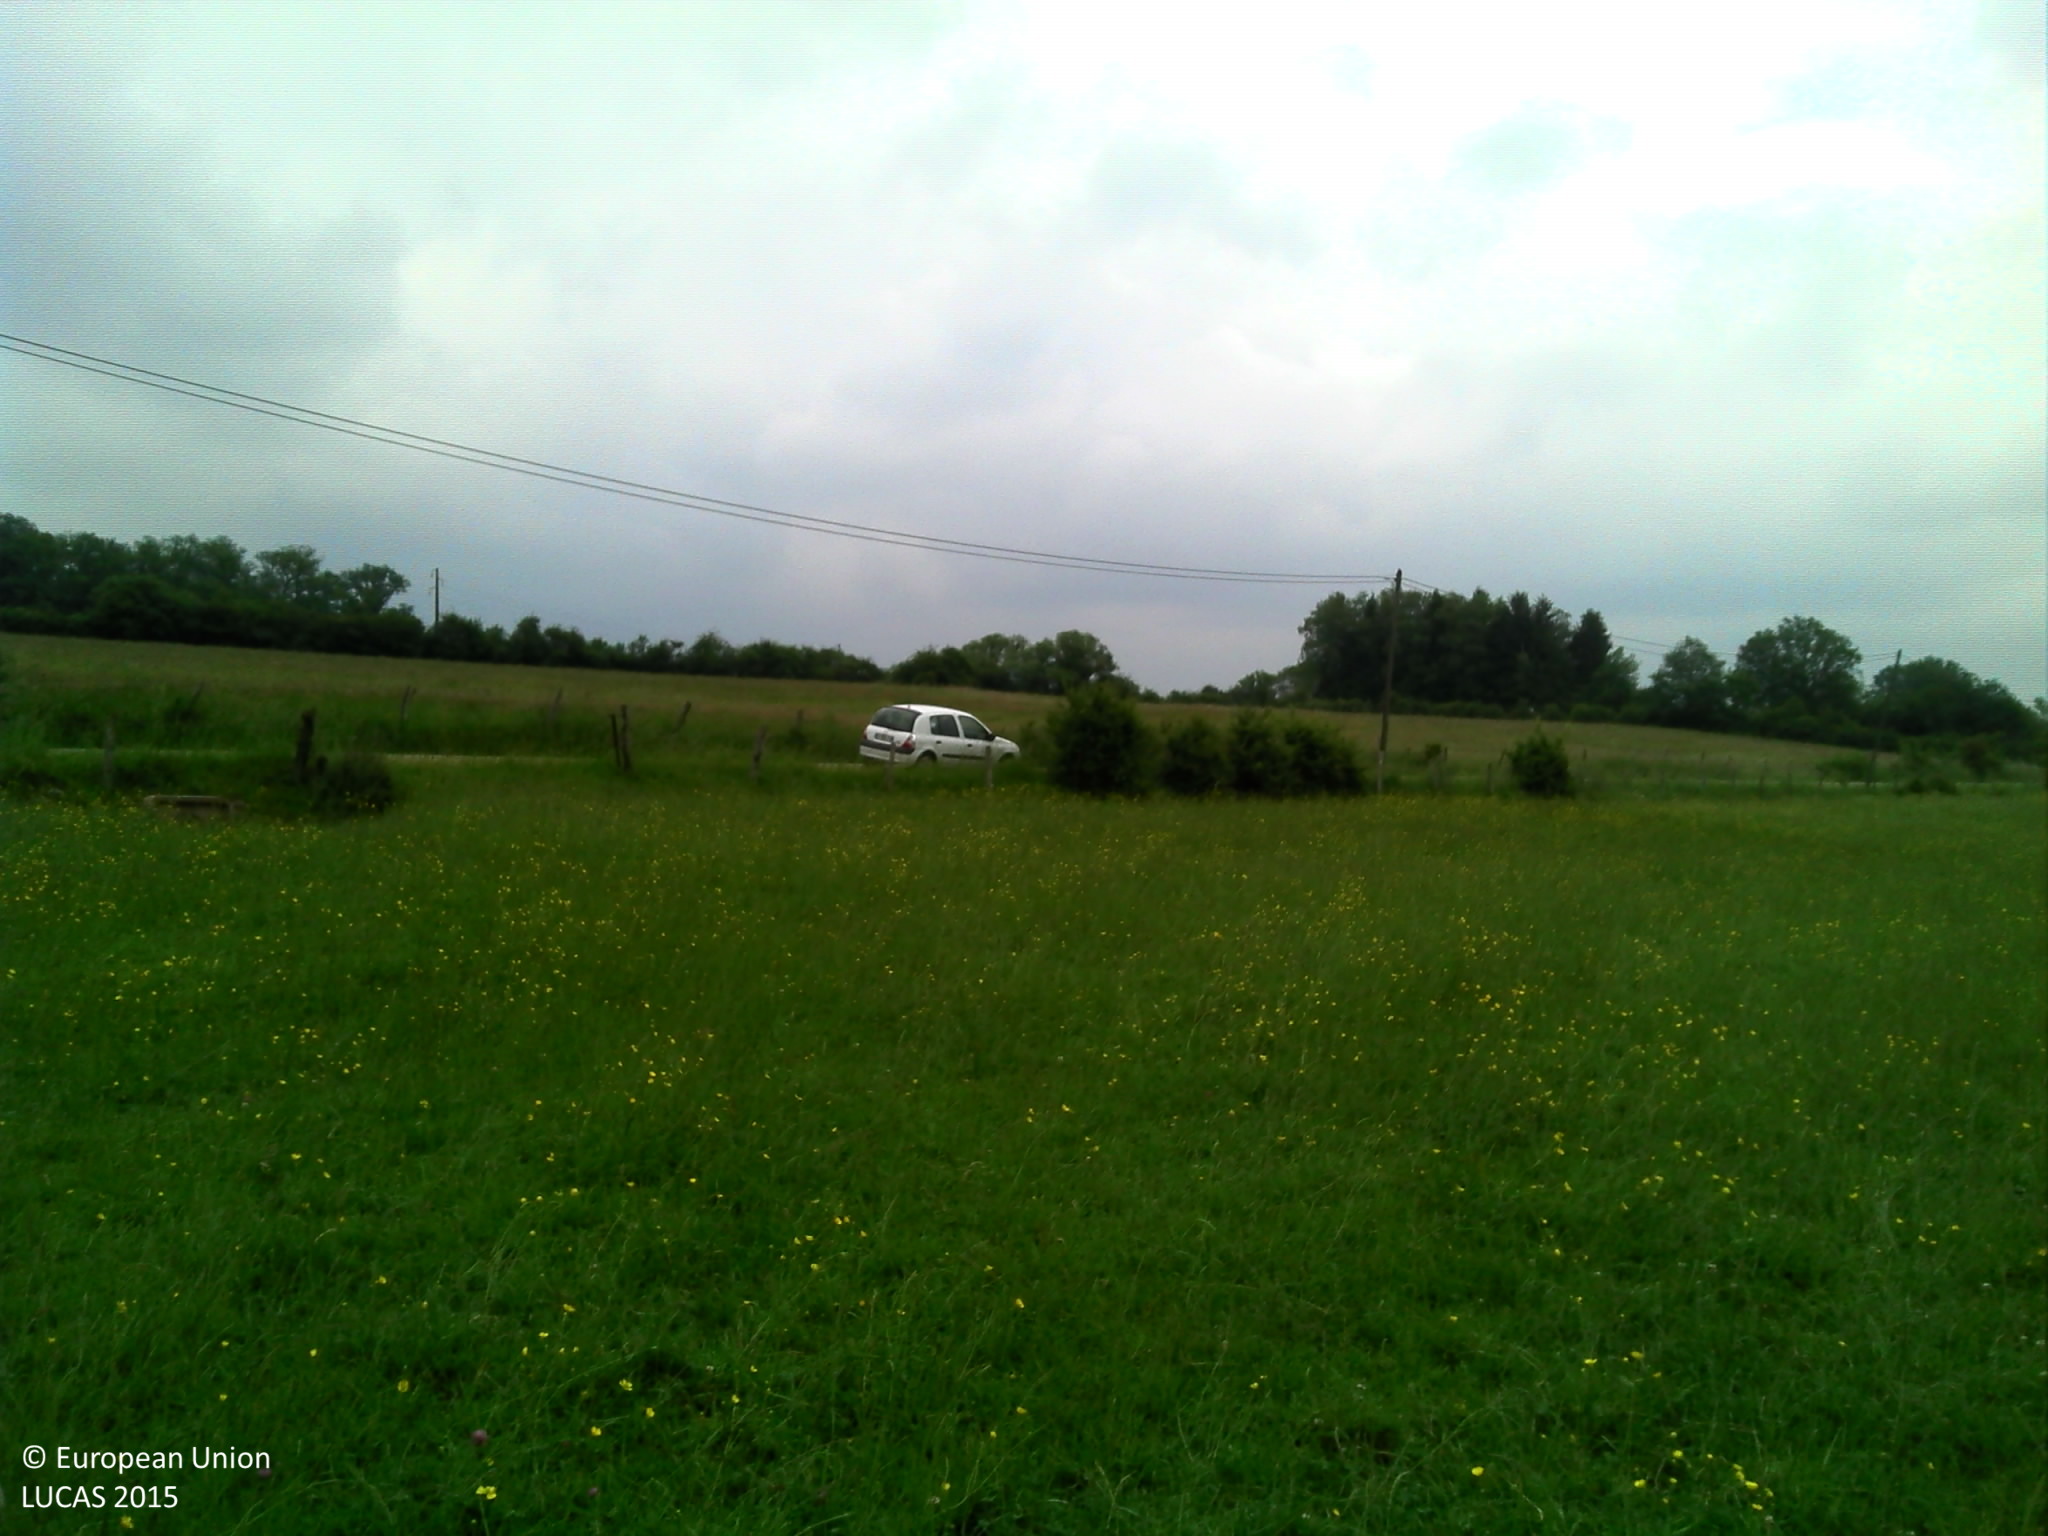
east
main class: Grassland
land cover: Grassland without tree/shrub cover
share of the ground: > 75 %
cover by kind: herbaceous plants 100 %
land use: Agriculture (excluding fallow land and kitchen gardens)
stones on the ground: < 10 %
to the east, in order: Grassland without tree/shrub cover; Fences; Grass margins; Electric lines; Grass margins; Paved roads, cycling and walking lanes; Grass margins; Ditches and canals; Grassland without tree/shrub cover; Abandoned hedges; Fences; Temporary grasslands
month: May
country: FR
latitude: 47.9064
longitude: 6.2148
